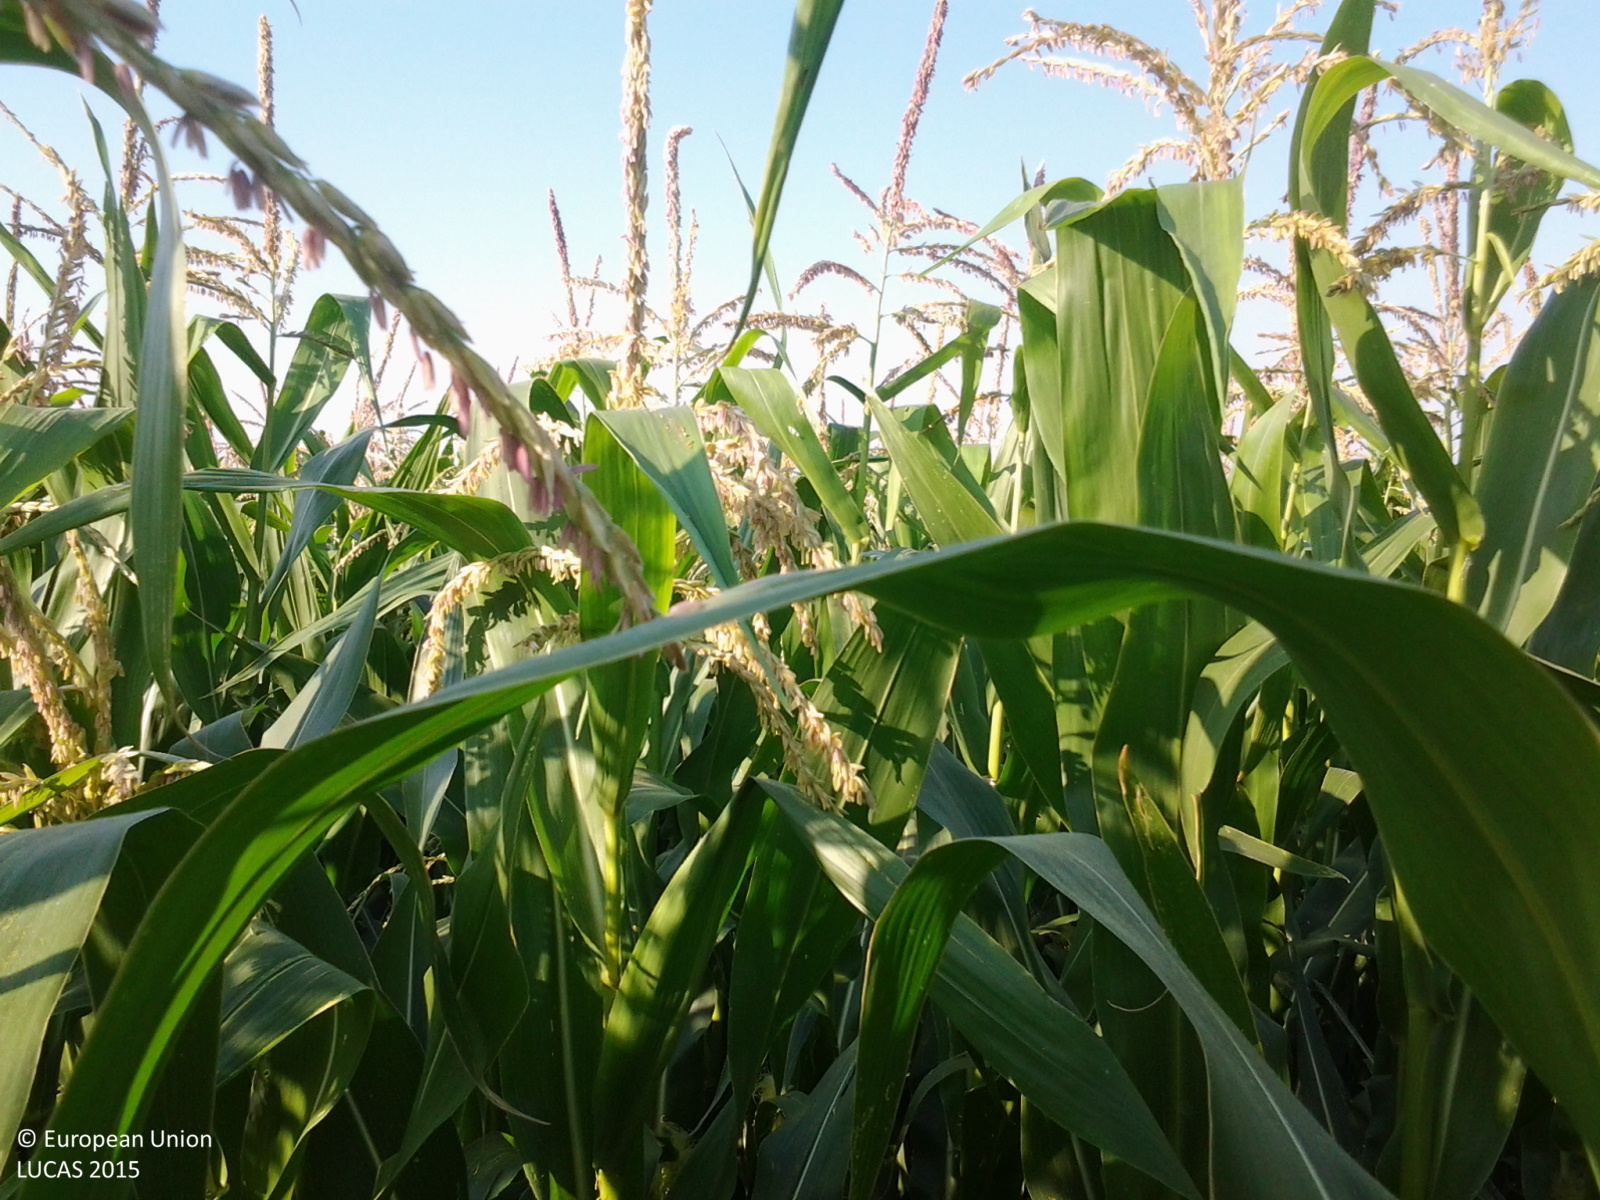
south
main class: Cropland
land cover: Maize
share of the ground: > 75 %
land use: Agriculture (excluding fallow land and kitchen gardens)
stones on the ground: < 10 %
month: July
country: HU
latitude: 47.0801
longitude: 20.7396
